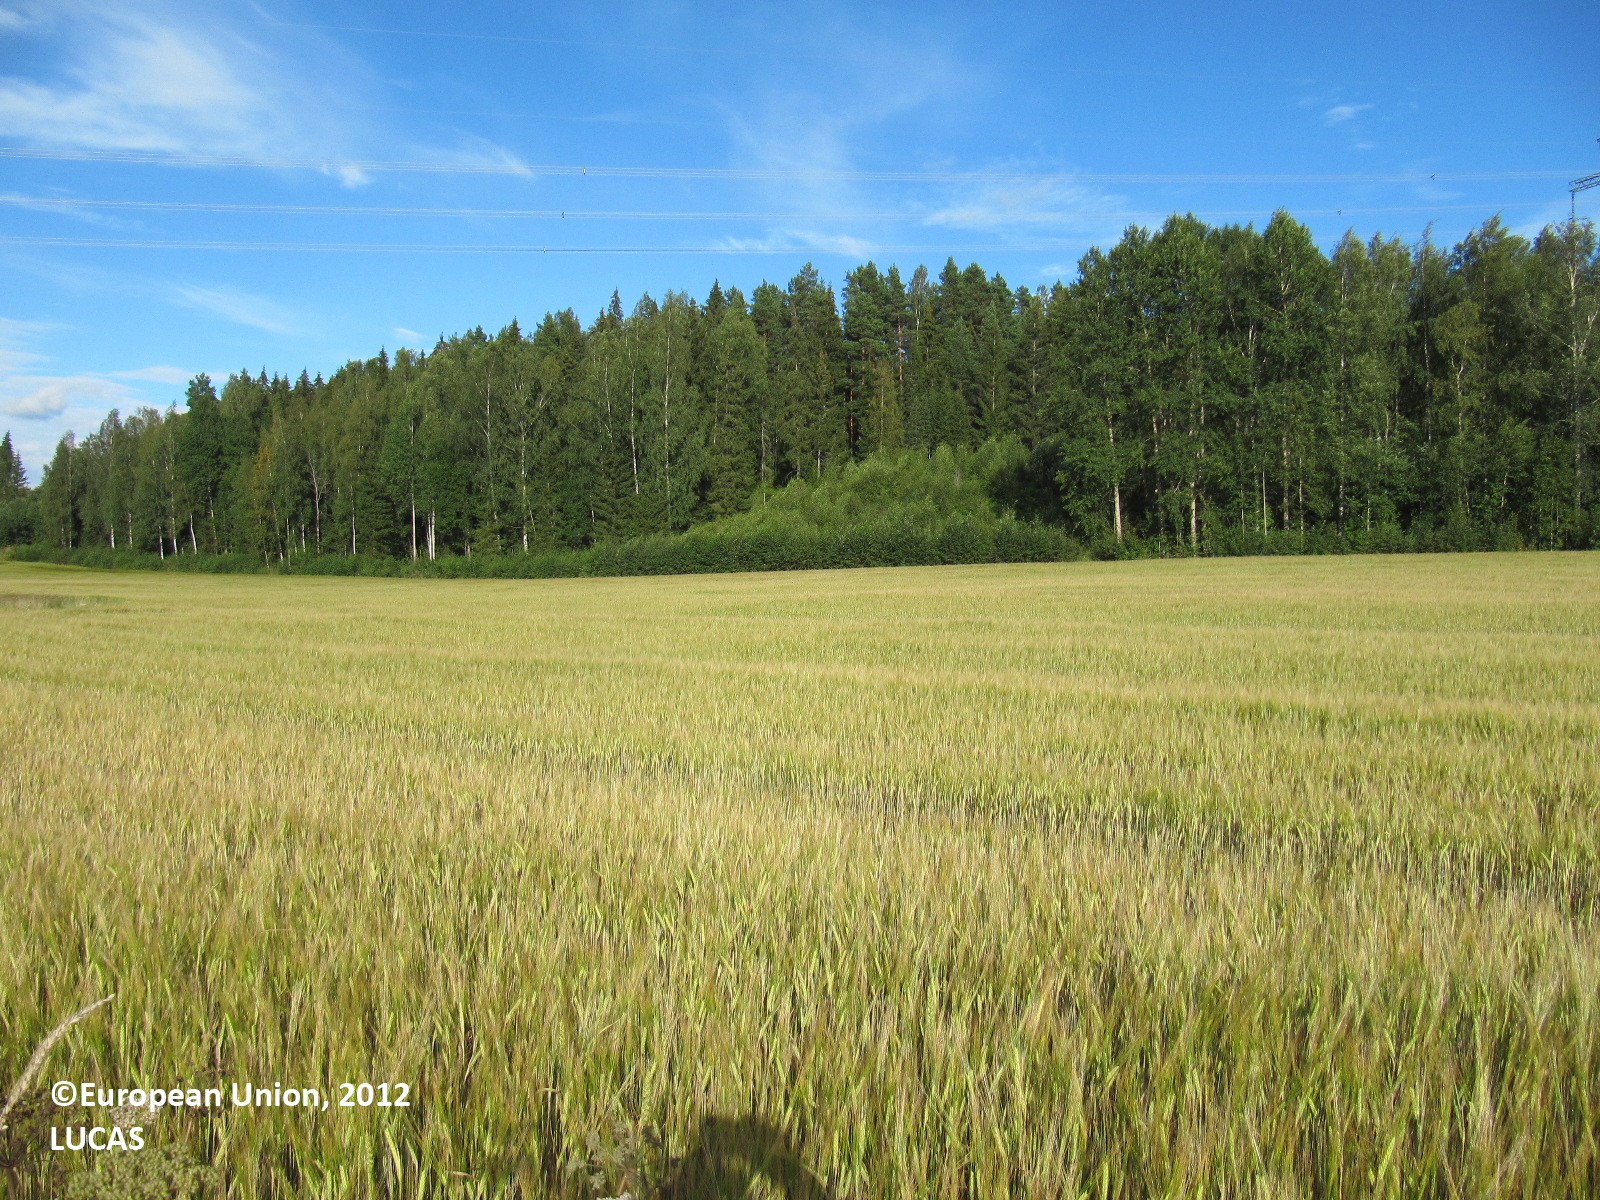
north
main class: Cropland
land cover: Barley
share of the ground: > 75 %
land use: Agriculture (excluding fallow land and kitchen gardens)
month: August
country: FI
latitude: 60.3097
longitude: 23.1681
